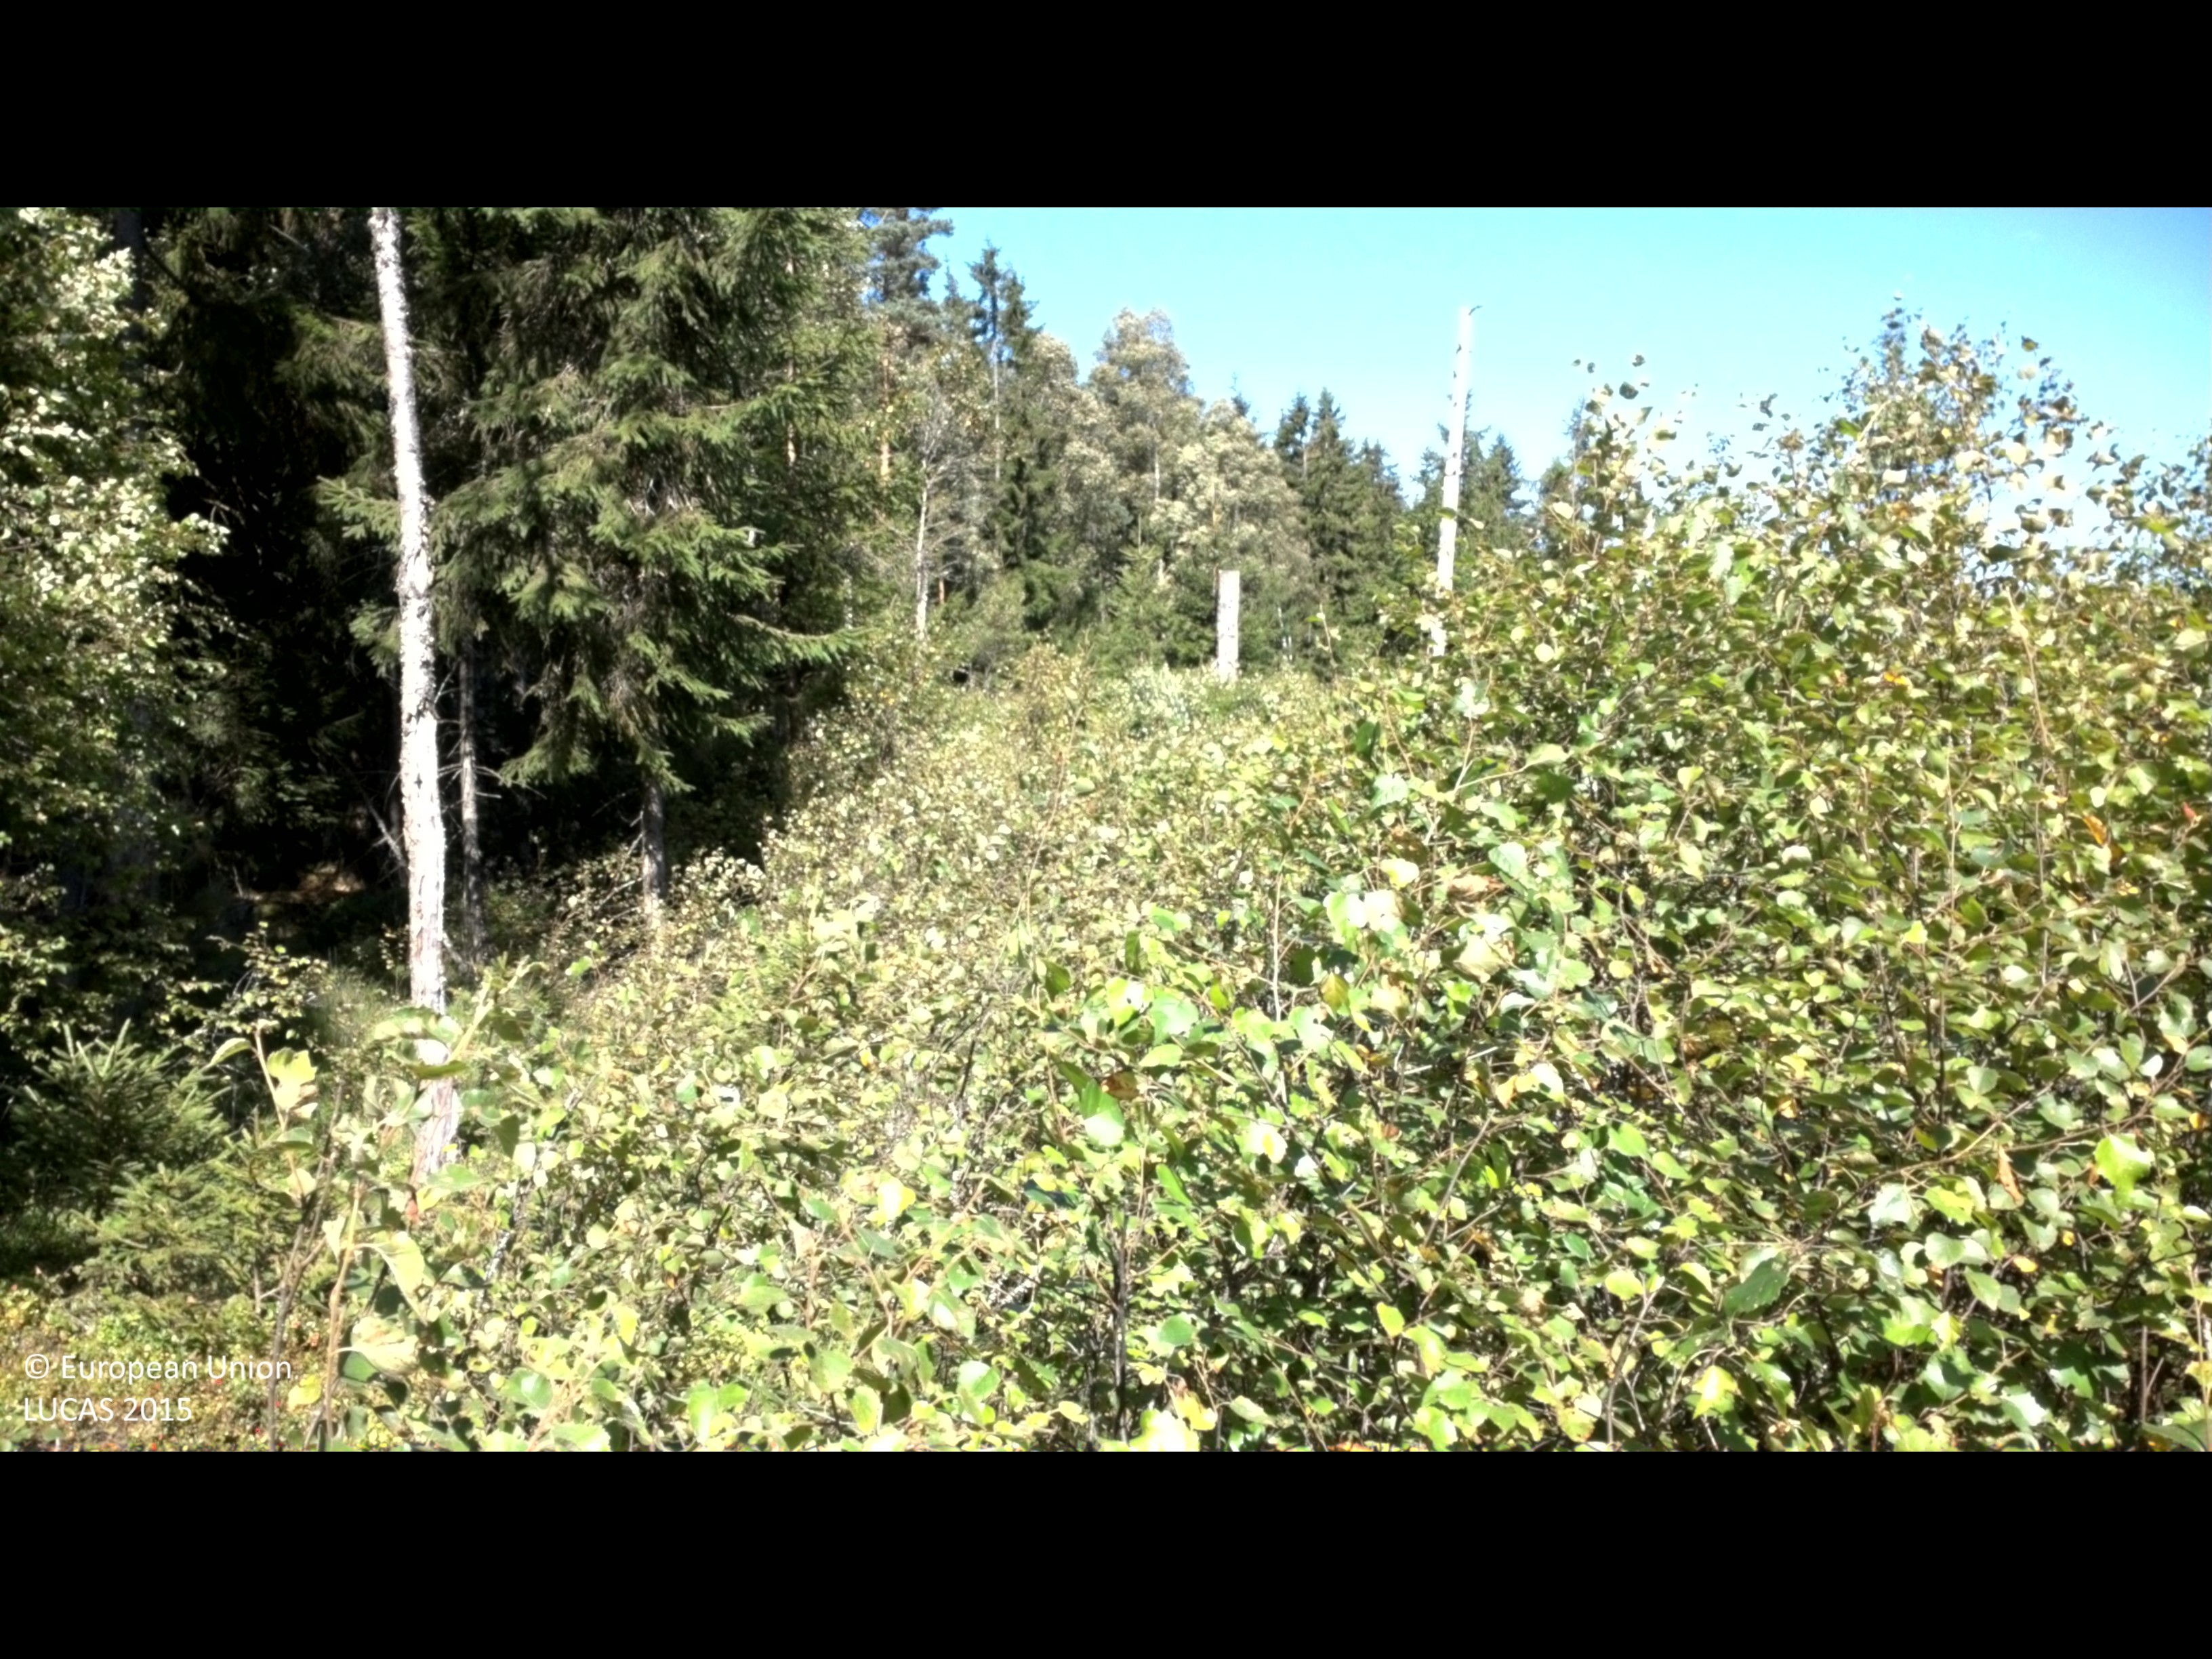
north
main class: Woodland
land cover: Spruce dominated mixed woodland
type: boreal forest
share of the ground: > 75 %
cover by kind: broadleaved forest trees 55 %, coniferous forest trees 30 %, shrubs 10 %, herbaceous plants 5 %
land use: Forestry
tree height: > 5 m
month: August
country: SE
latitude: 56.7281
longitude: 14.2953
